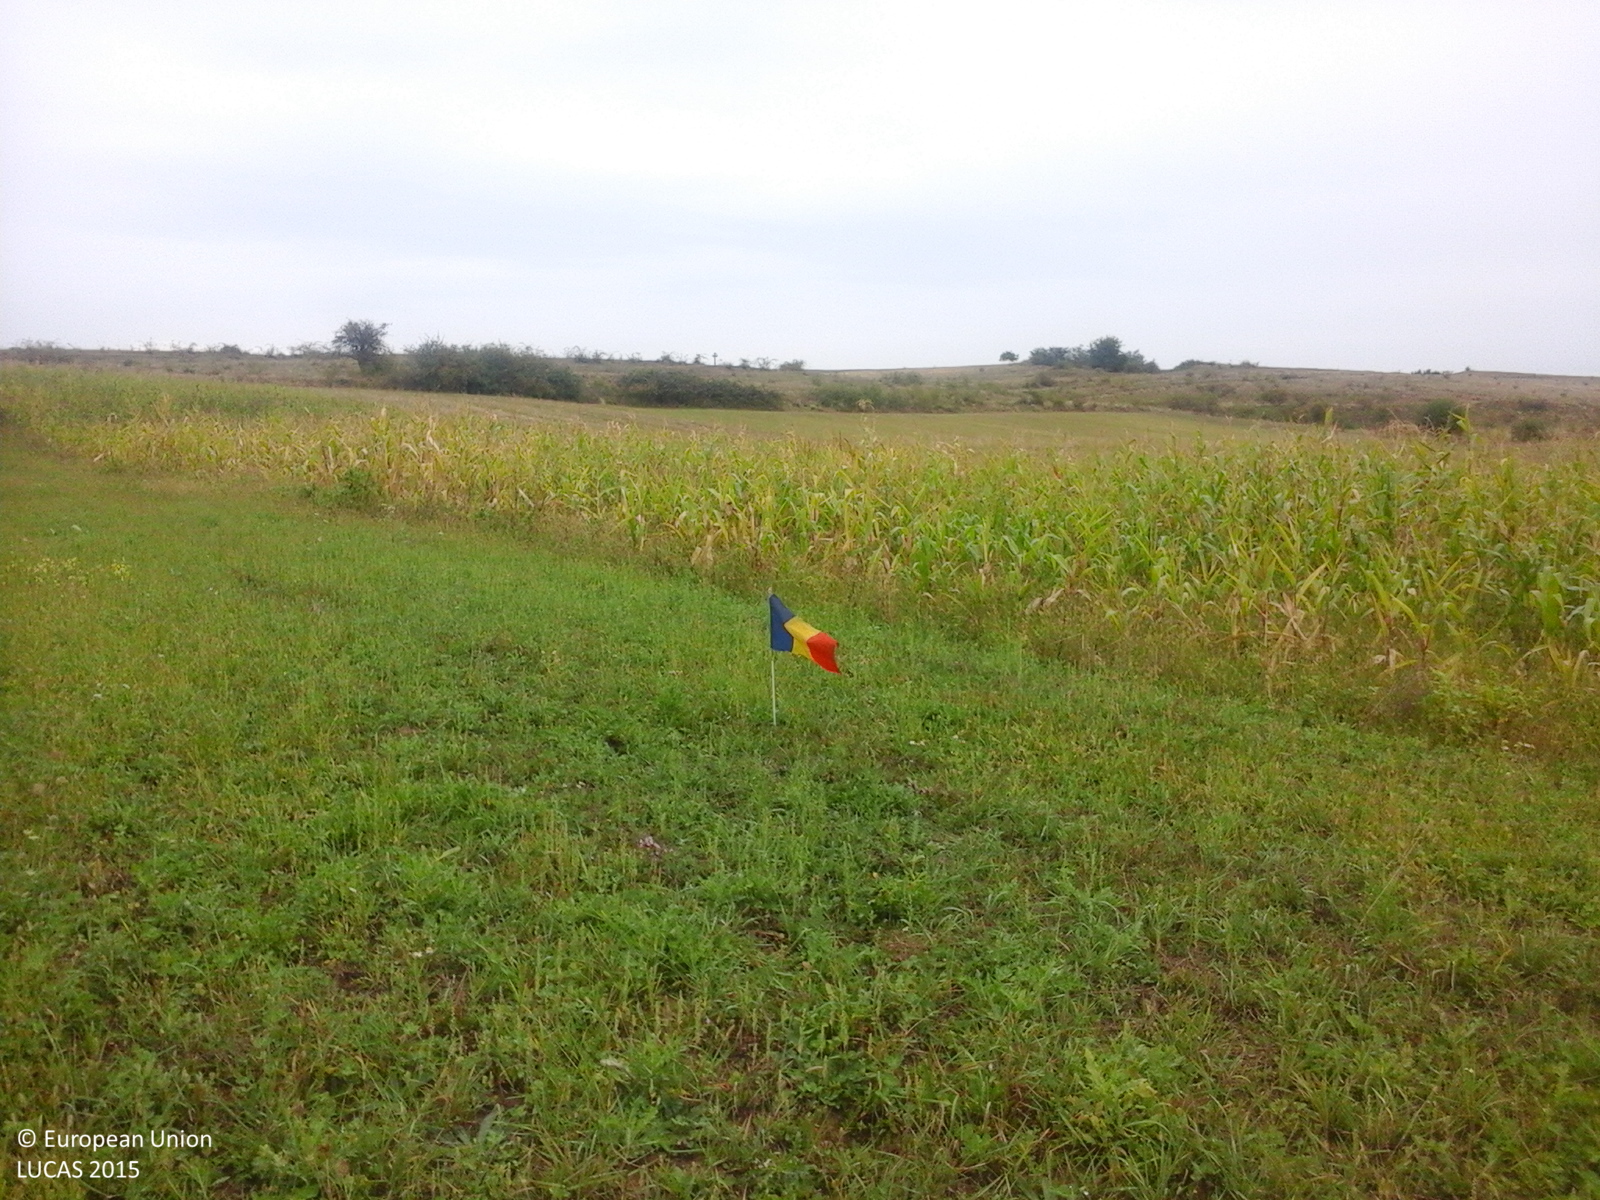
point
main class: Grassland
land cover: Grassland without tree/shrub cover
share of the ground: > 75 %
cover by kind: herbaceous plants 100 %
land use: Agriculture (excluding fallow land and kitchen gardens)
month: September
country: RO
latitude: 47.3906
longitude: 22.5768
